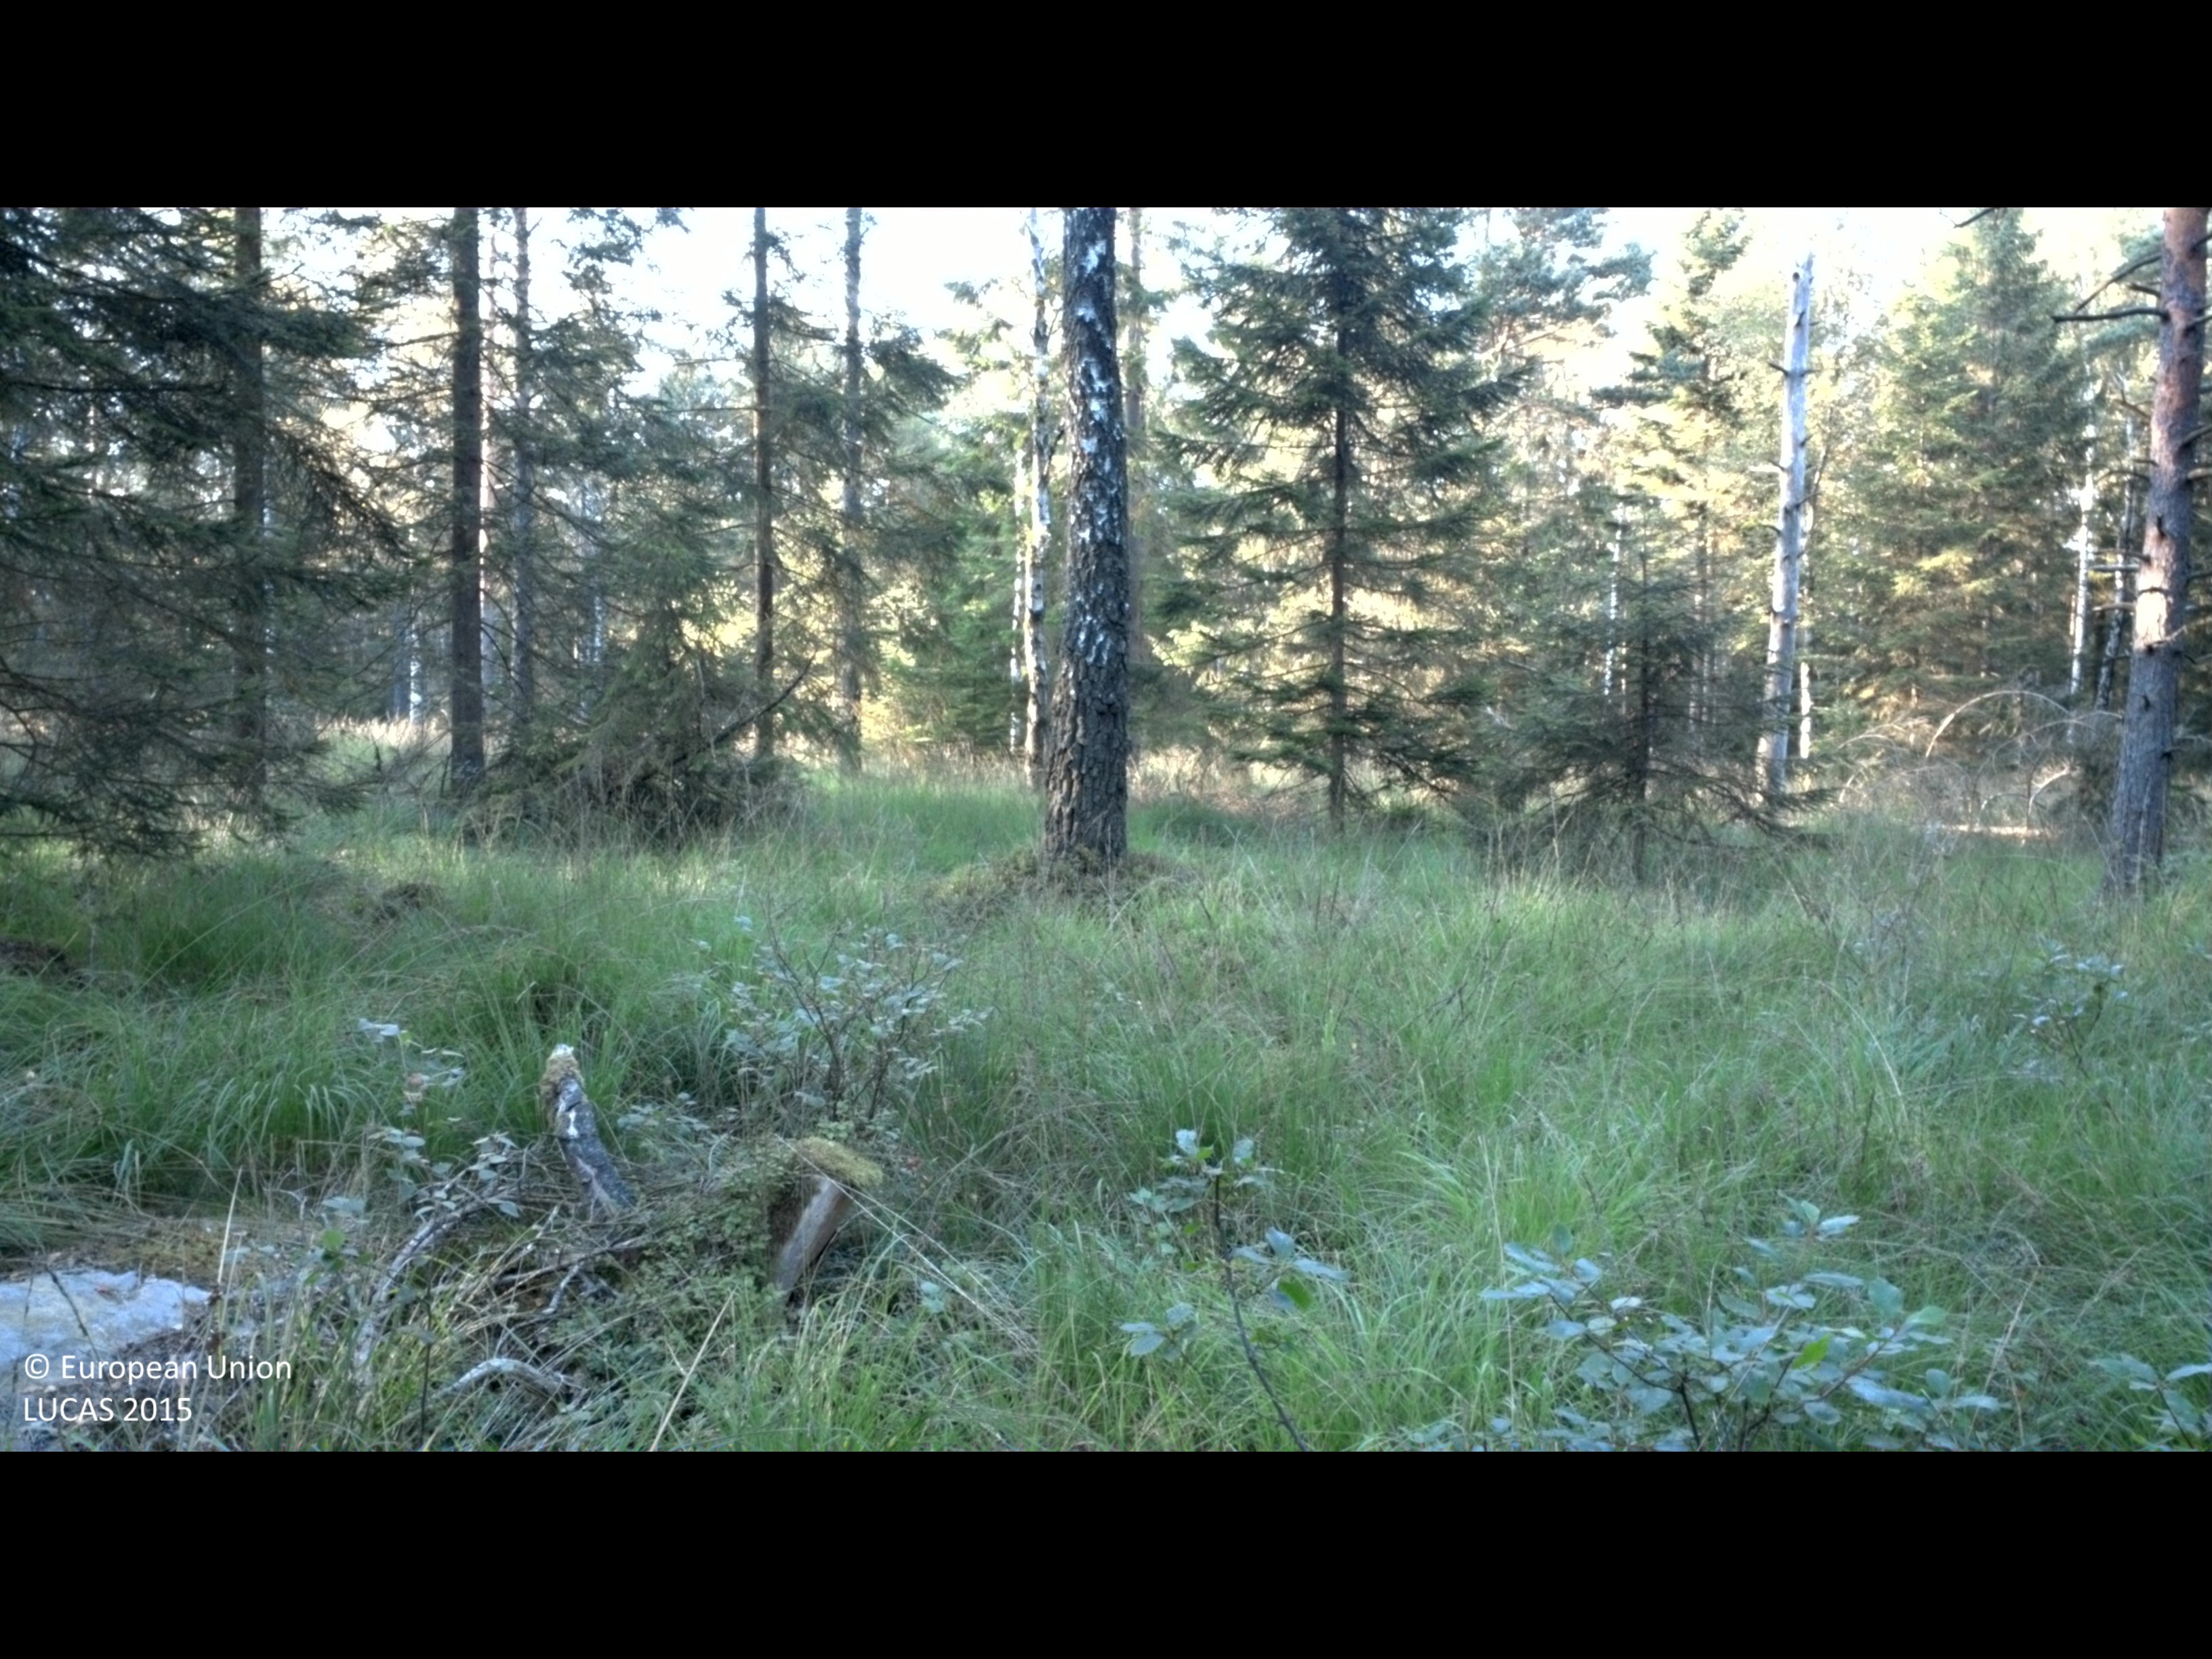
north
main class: Woodland
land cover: Pine dominated mixed woodland
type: boreal forest
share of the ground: 50 - 75 %
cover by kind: coniferous forest trees 45 %, herbaceous plants 30 %, broadleaved forest trees 15 %, shrubs 10 %
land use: Forestry
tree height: > 5 m
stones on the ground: < 10 %
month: August
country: SE
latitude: 56.7428
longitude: 13.1523
